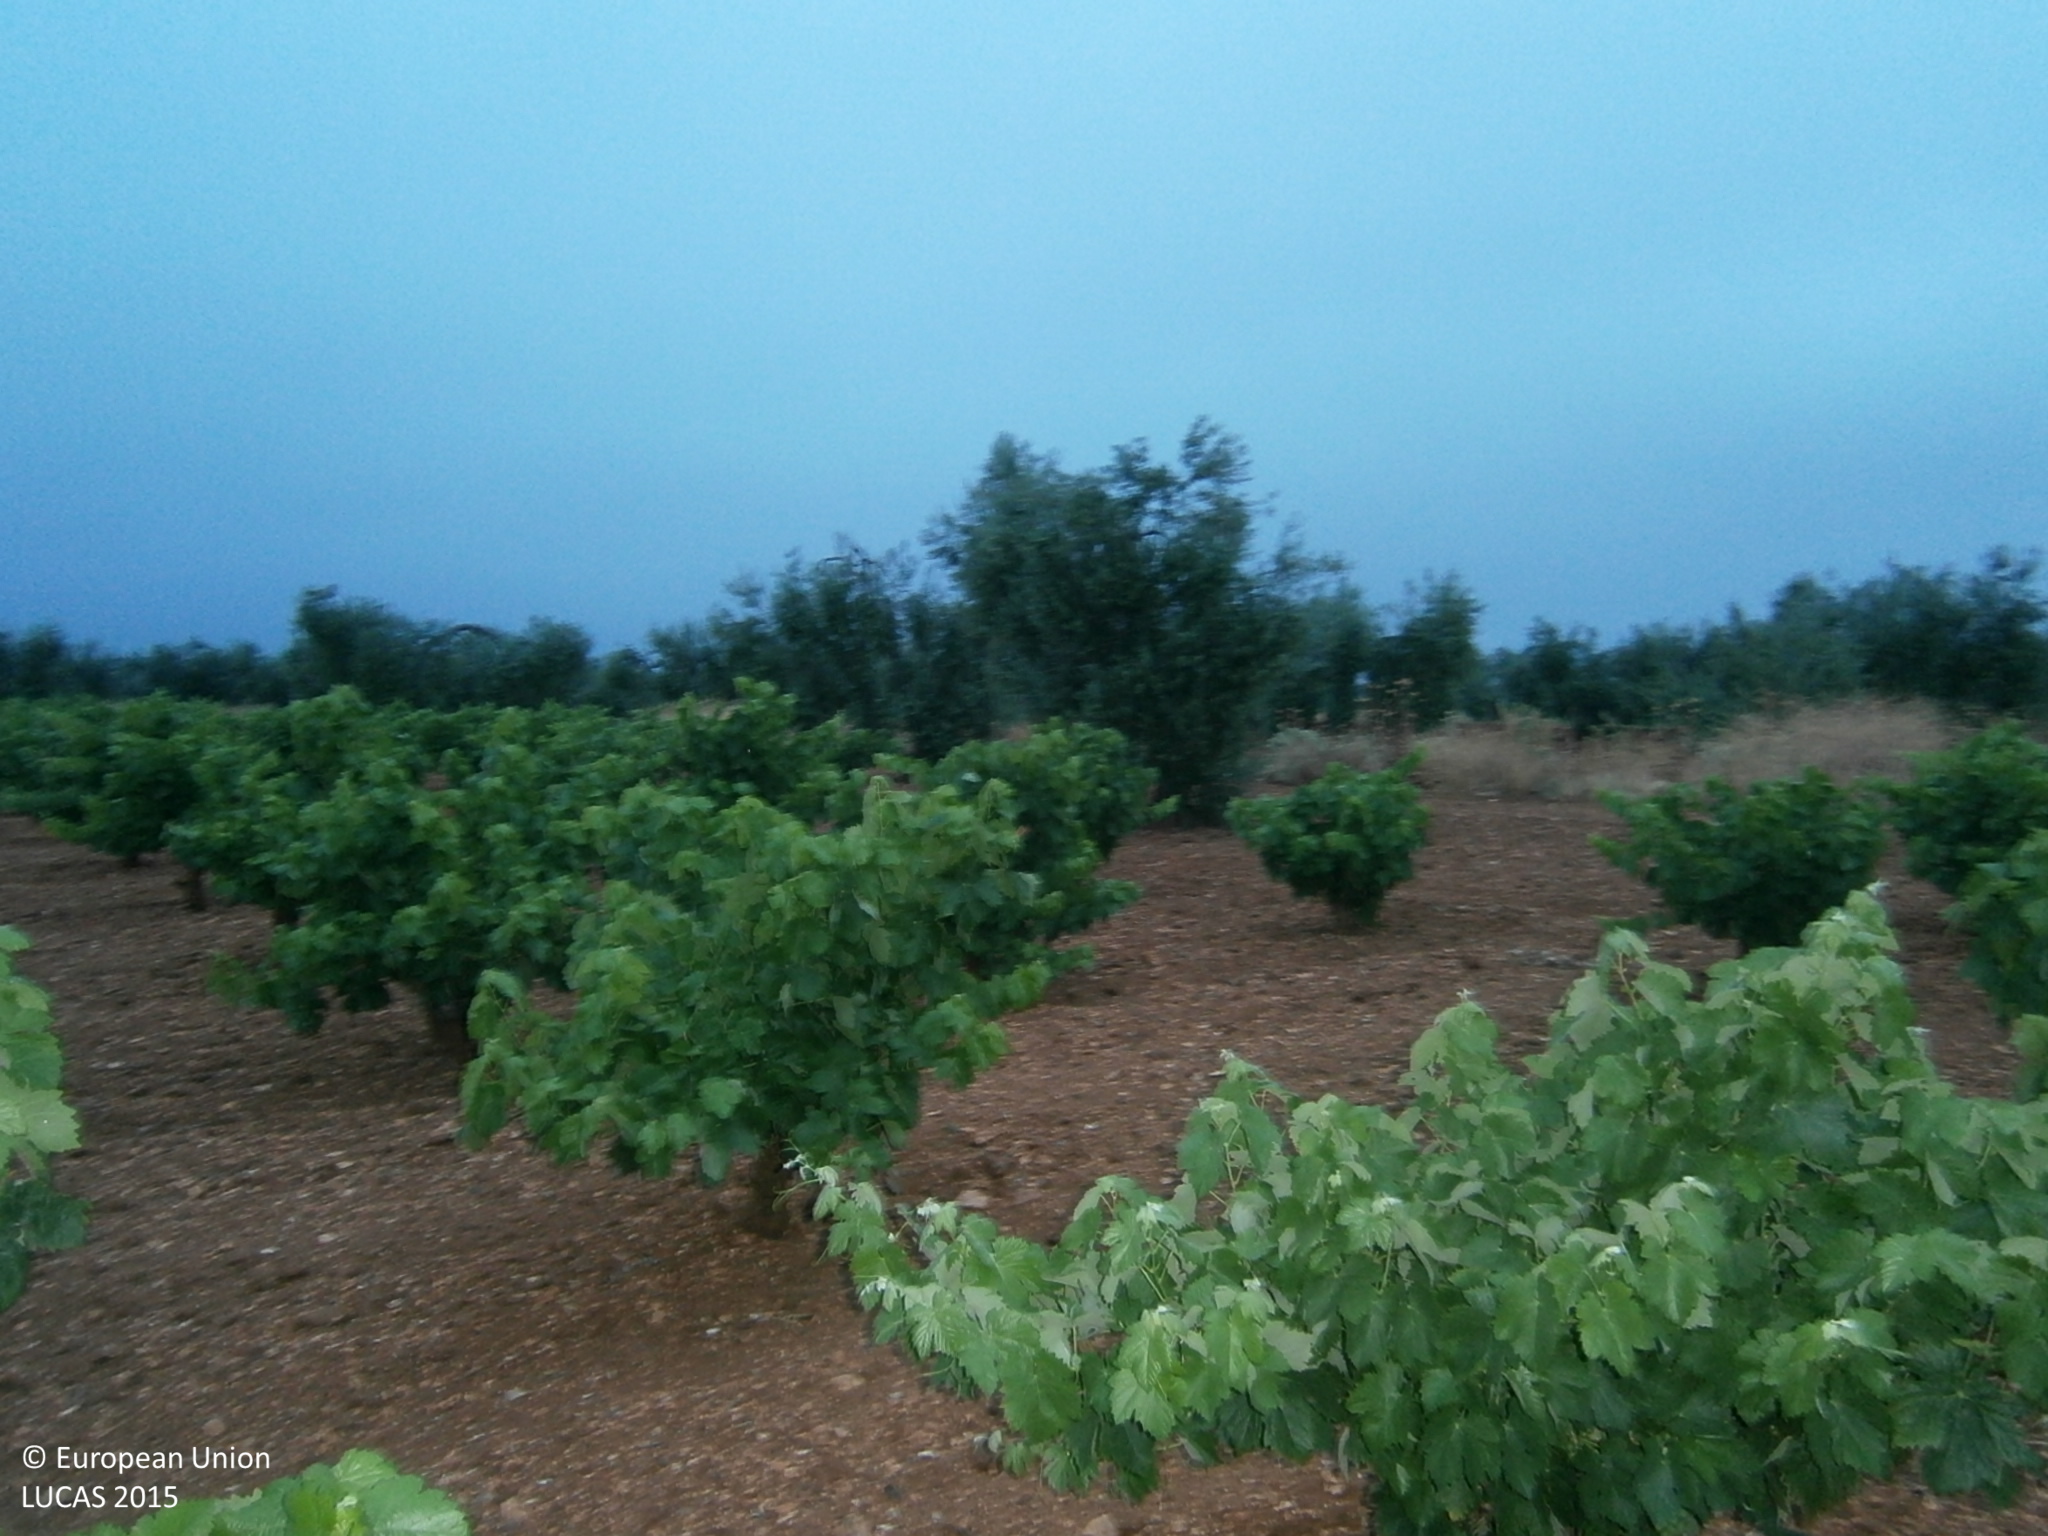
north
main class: Cropland
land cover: Vineyards
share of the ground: 25 - 50 %
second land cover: Other bare soil
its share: > 75 %
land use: Agriculture (excluding fallow land and kitchen gardens)
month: June
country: ES
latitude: 38.5623
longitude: -6.4063
